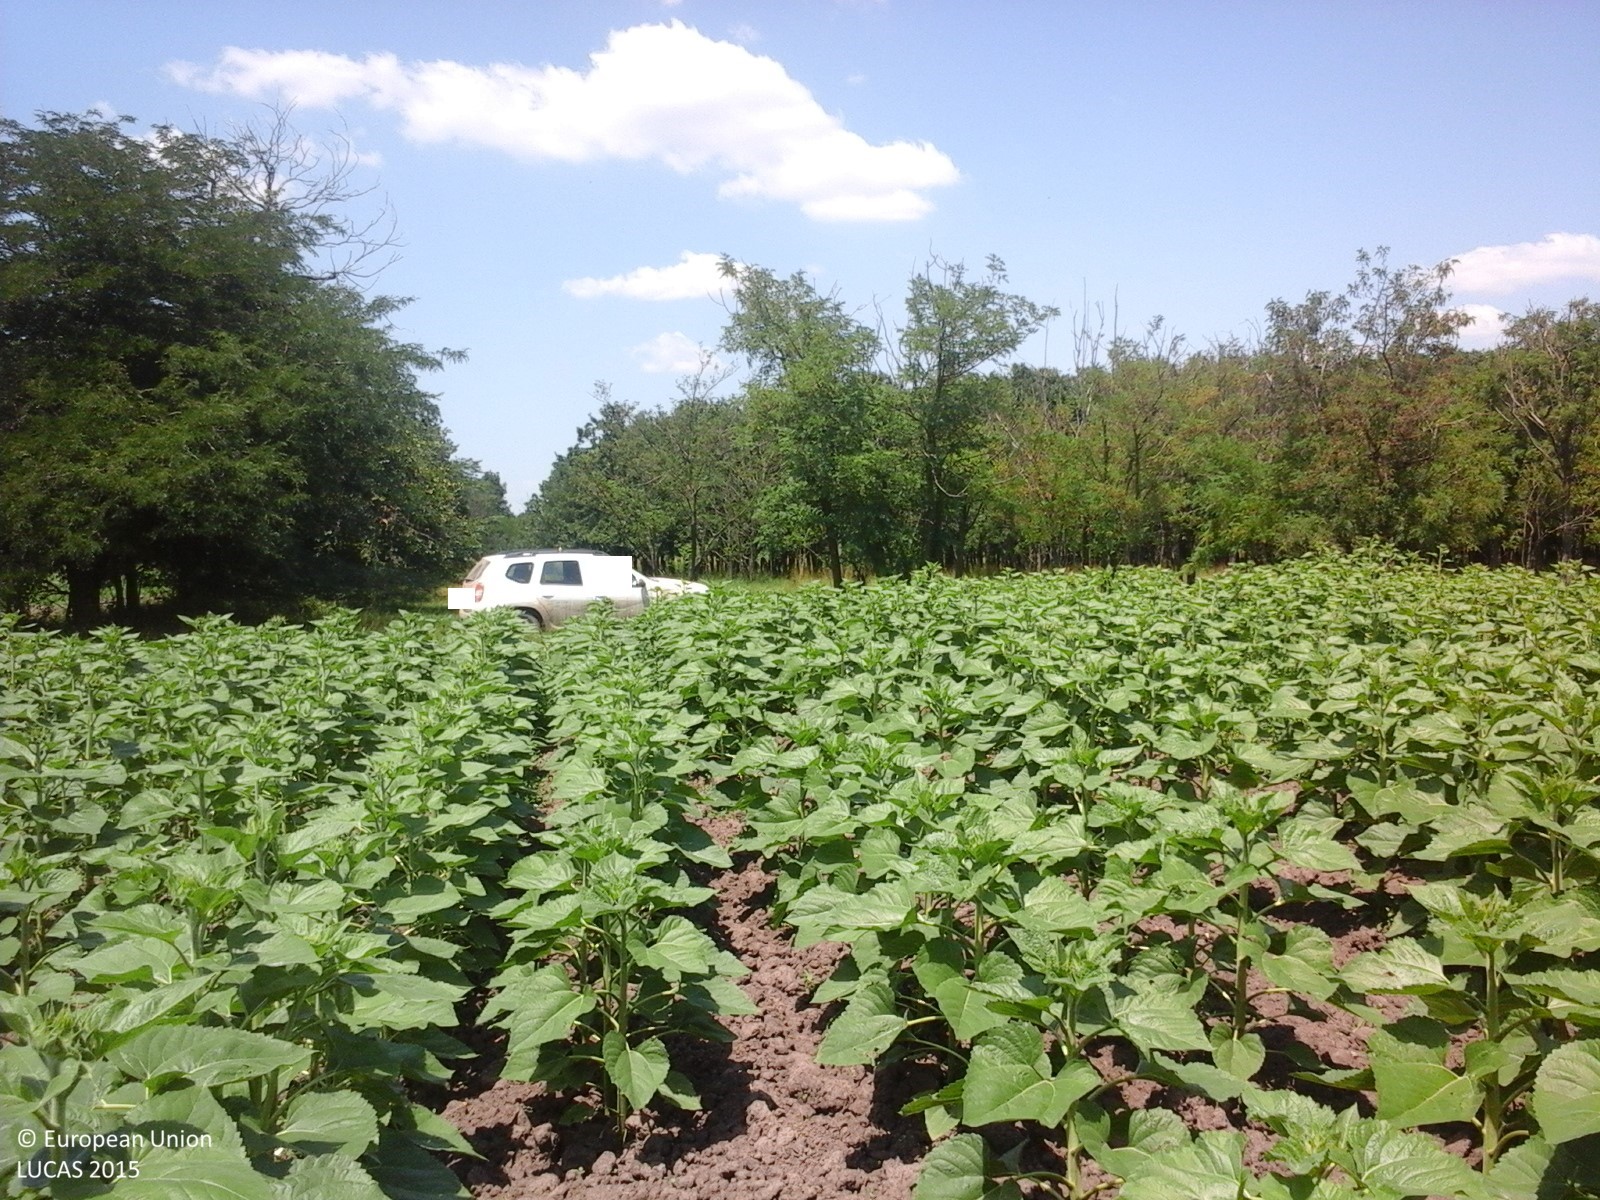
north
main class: Cropland
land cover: Sunflower
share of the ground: > 75 %
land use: Agriculture (excluding fallow land and kitchen gardens)
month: July
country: RO
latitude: 44.2154
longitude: 24.6784
